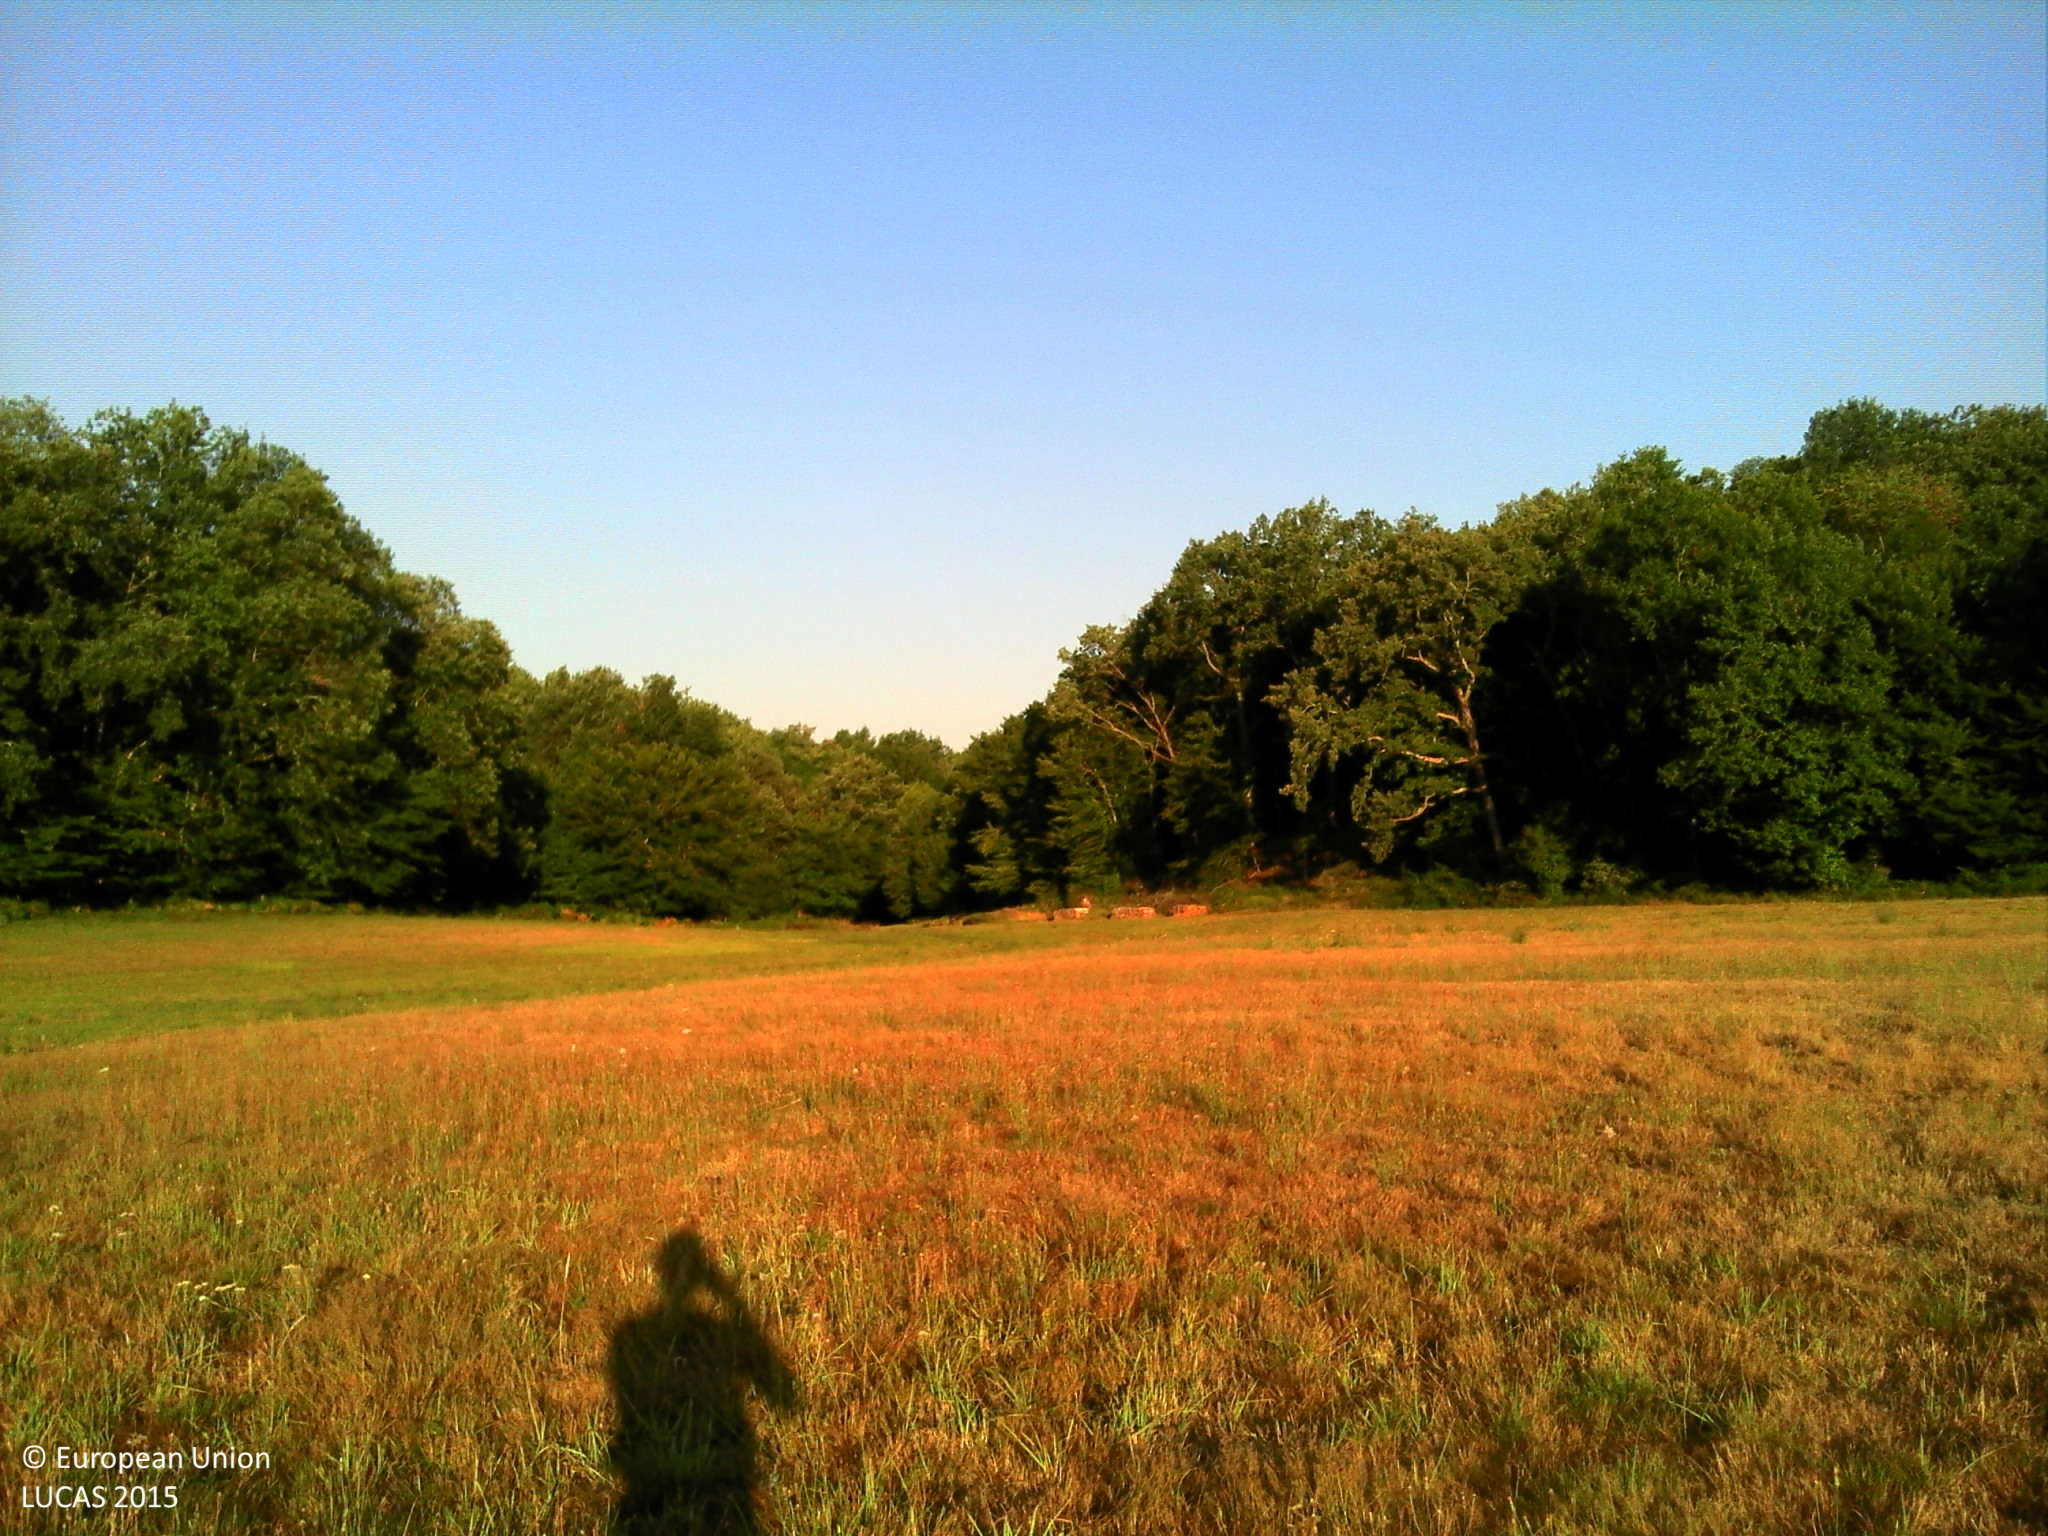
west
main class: Grassland
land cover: Grassland without tree/shrub cover
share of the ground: > 75 %
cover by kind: herbaceous plants 90 %, shrubs 5 %, lichens and mosses 5 %
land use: Agriculture (excluding fallow land and kitchen gardens)
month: August
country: FR
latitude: 44.8253
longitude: 0.7468
